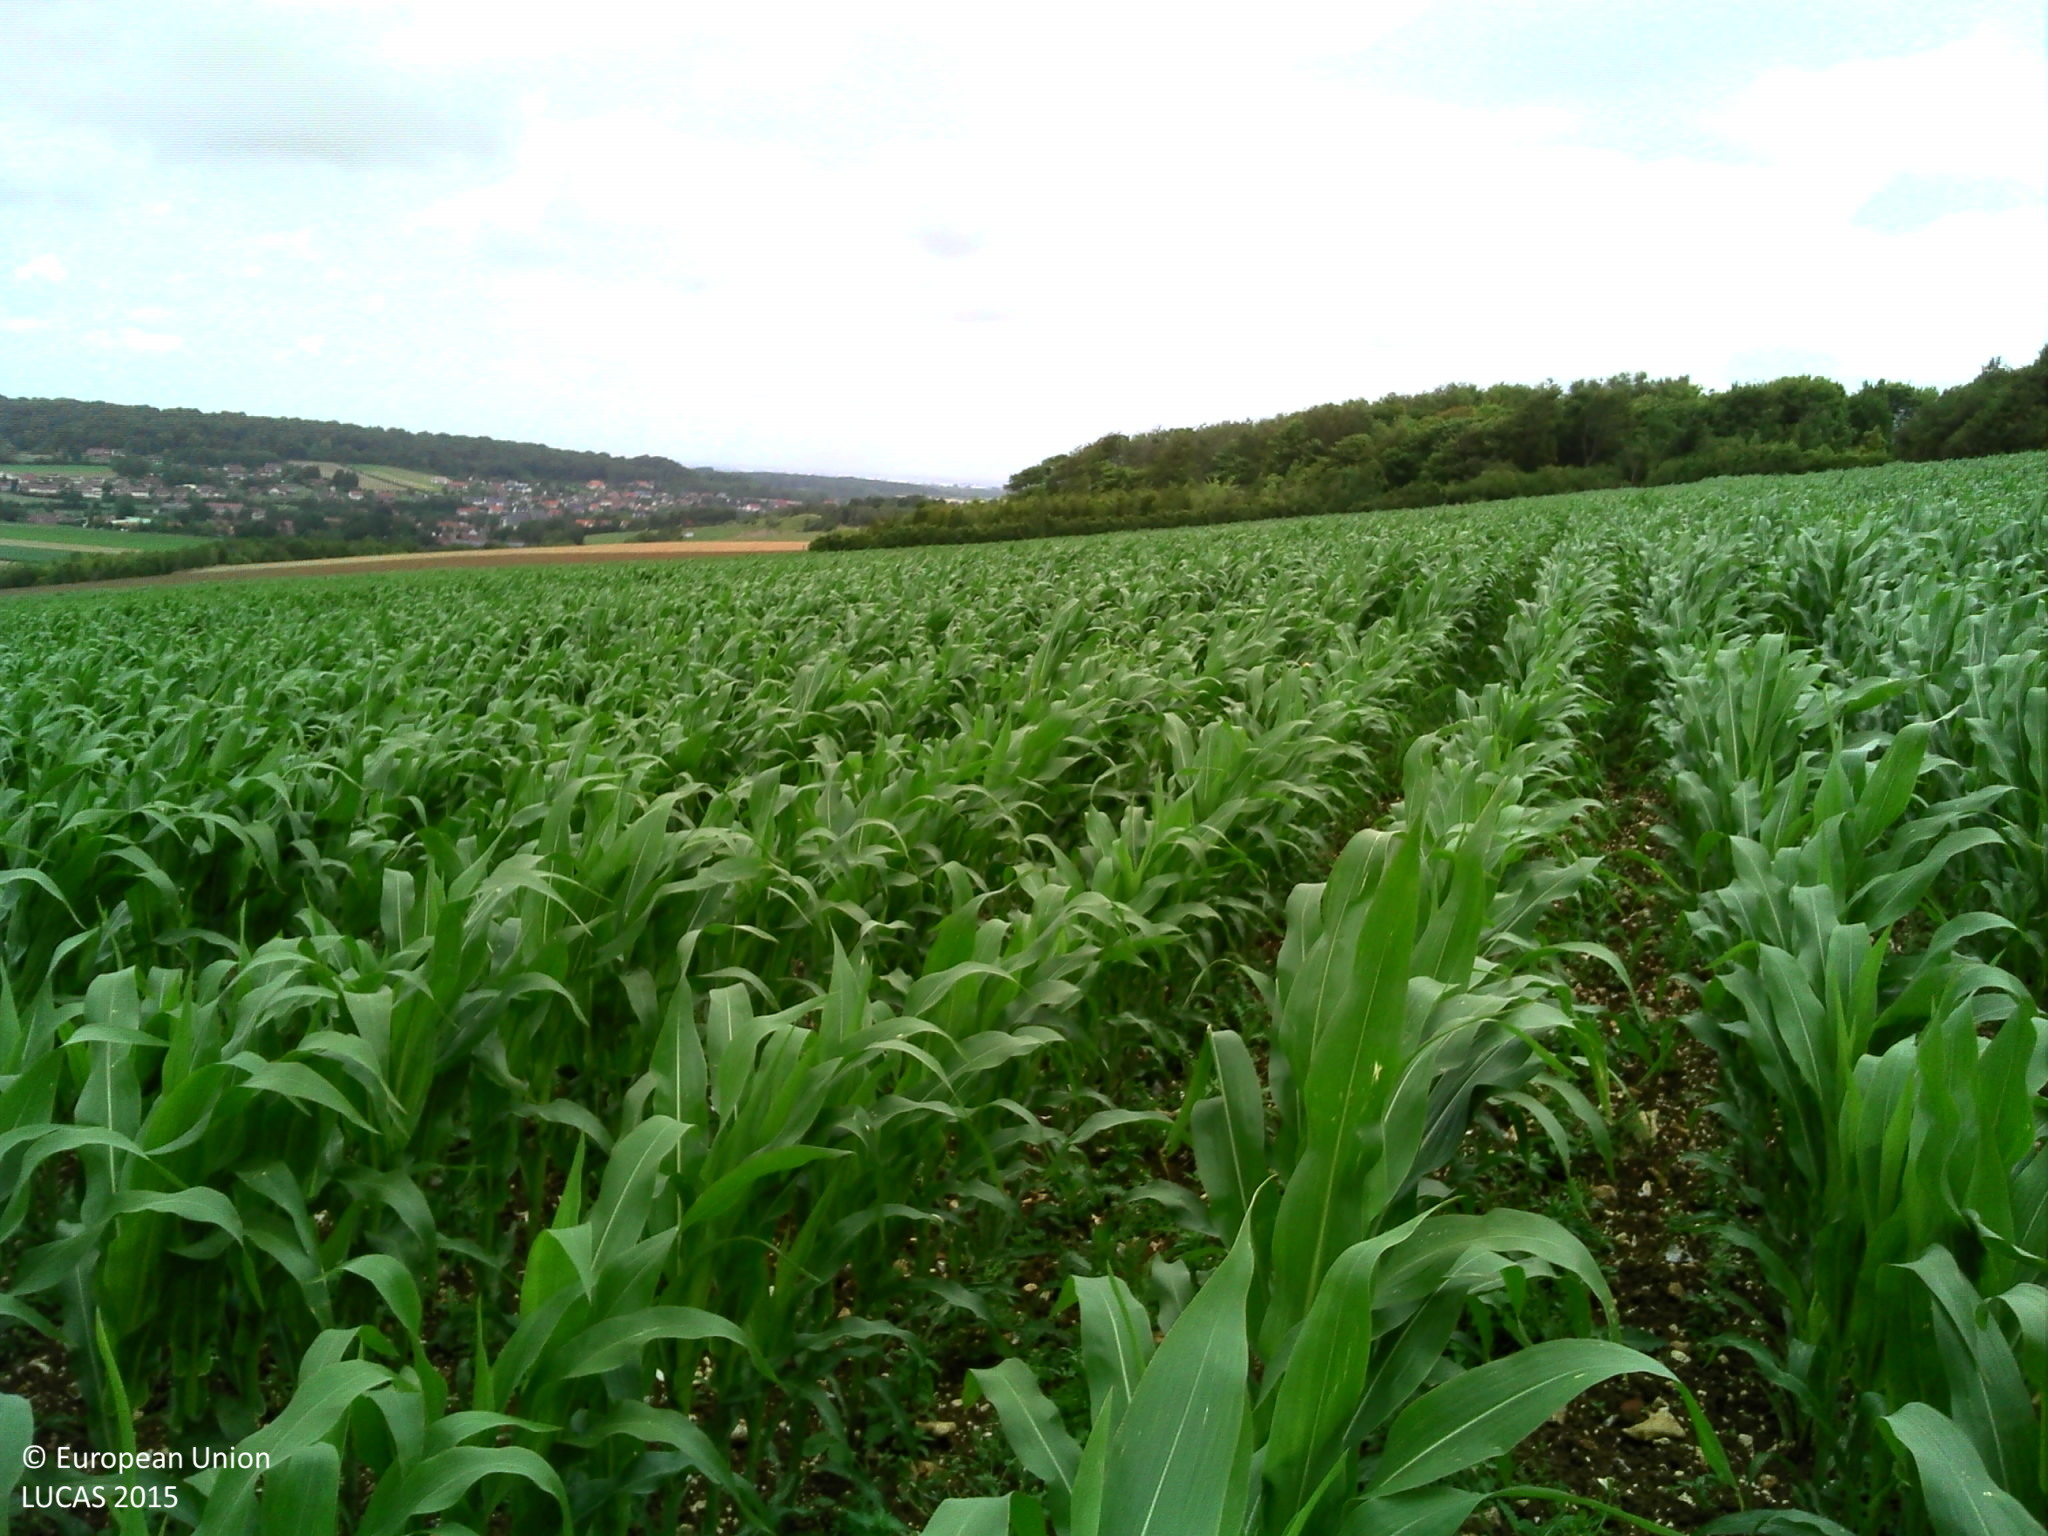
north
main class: Cropland
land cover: Maize
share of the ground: > 75 %
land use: Agriculture (excluding fallow land and kitchen gardens)
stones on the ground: 25 - 50 %
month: July
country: FR
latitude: 50.7921
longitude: 2.0544
